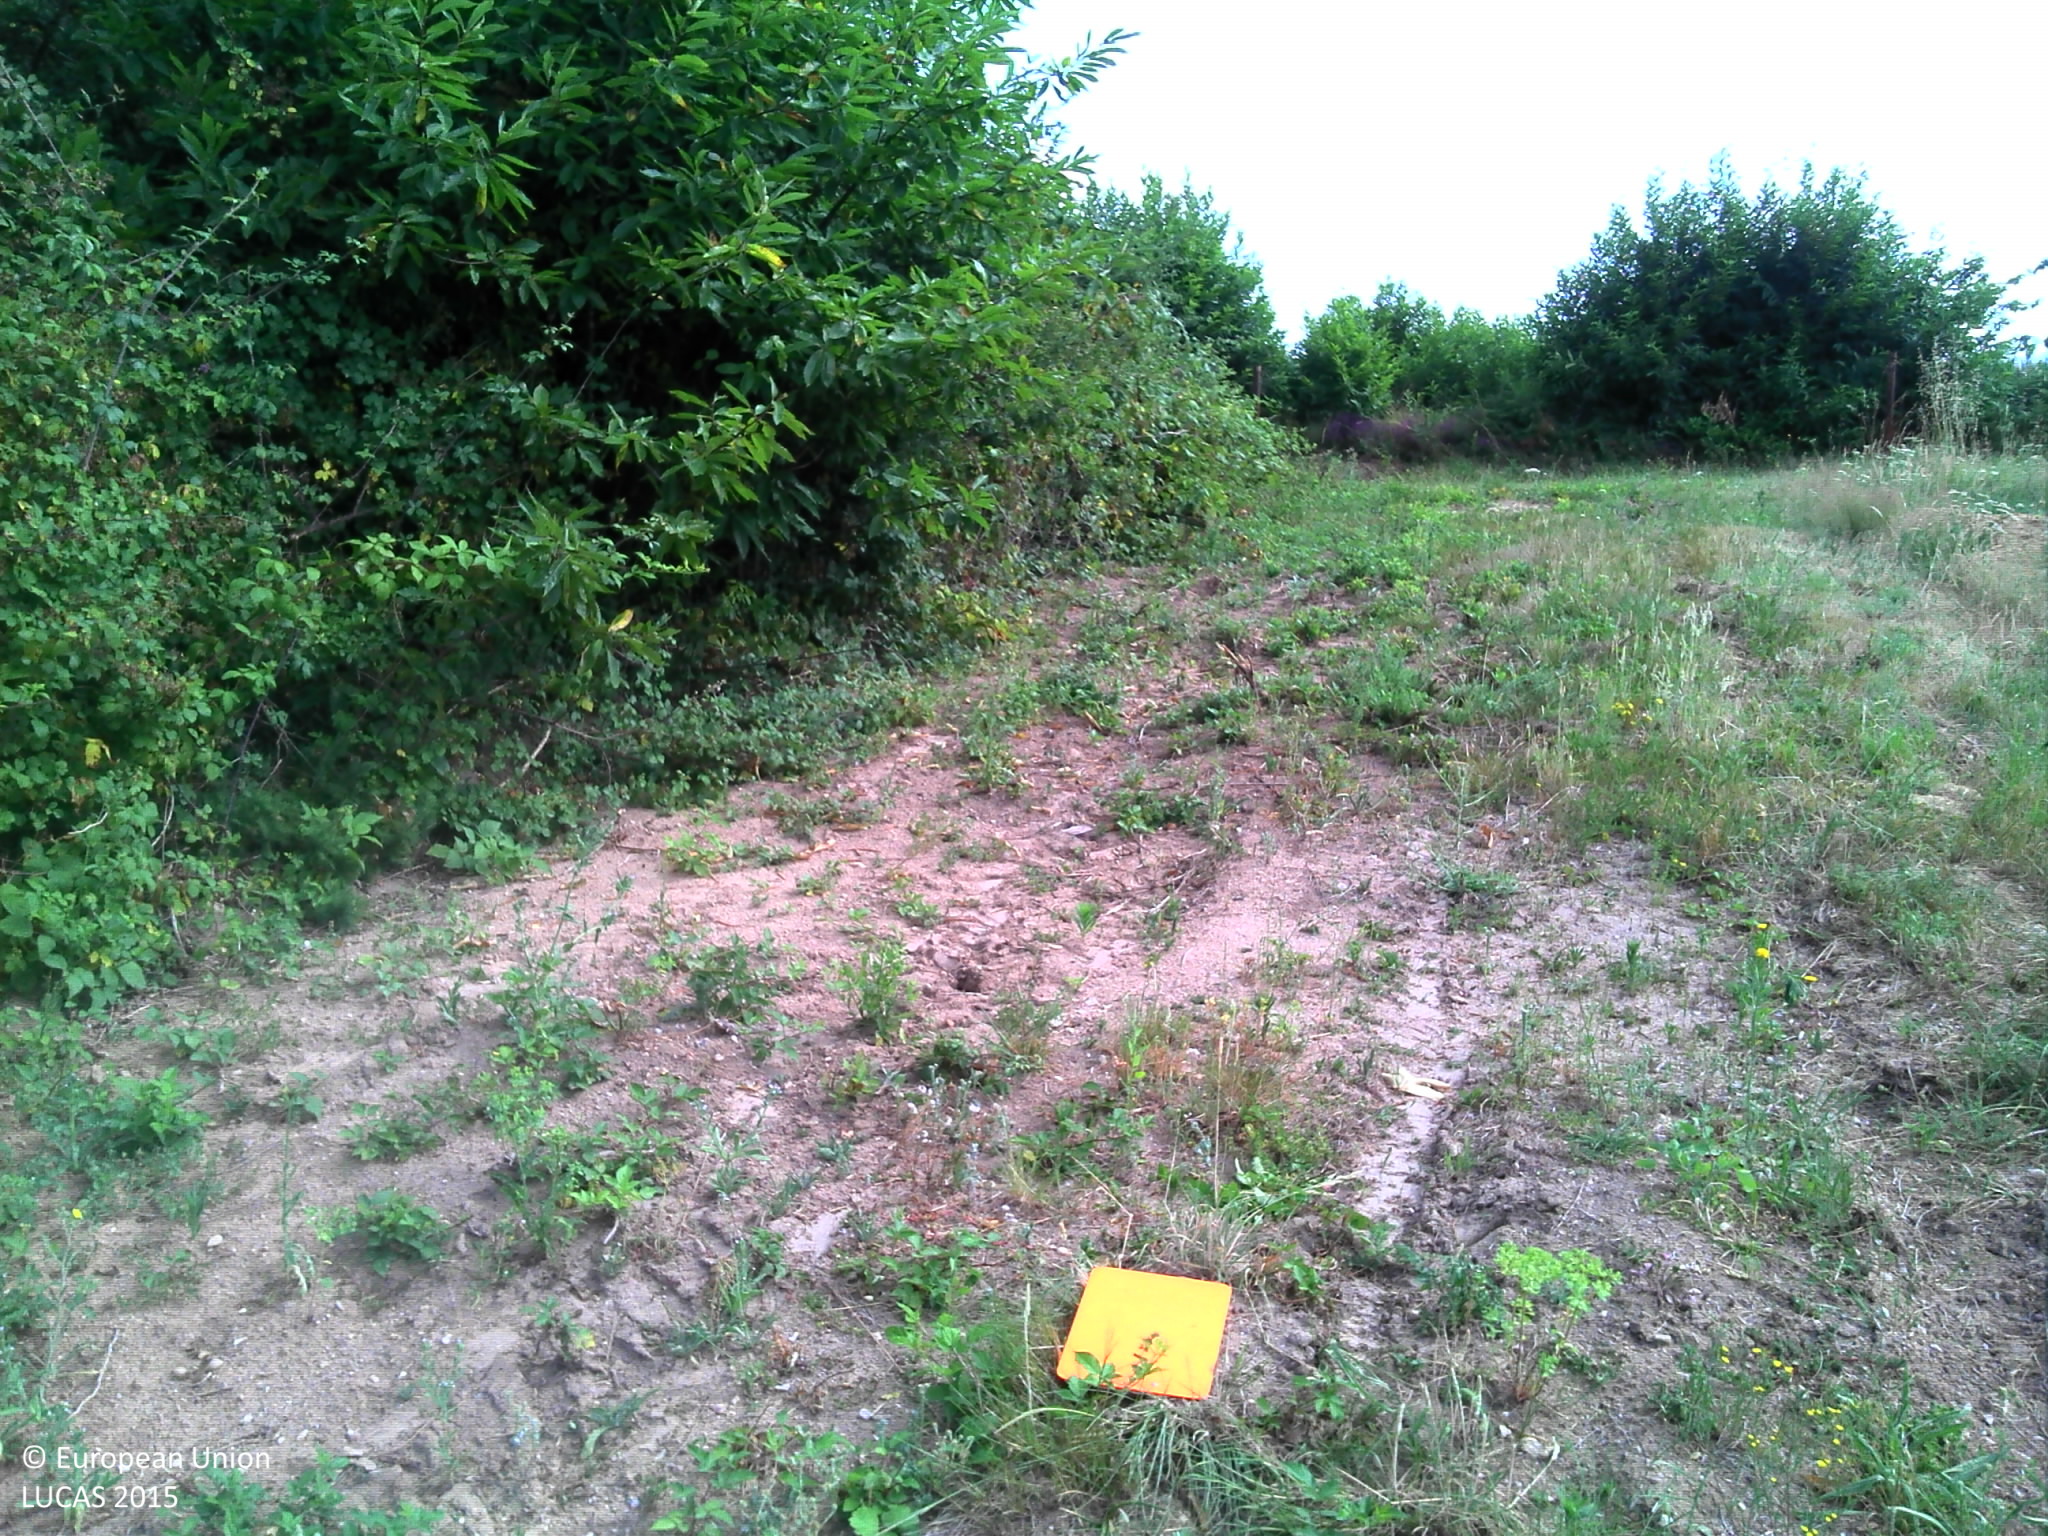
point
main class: Grassland
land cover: Spontaneously vegetated surfaces
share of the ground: > 75 %
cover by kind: herbaceous plants 95 %, shrubs 5 %
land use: Semi-natural and natural areas not in use
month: July
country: FR
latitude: 45.3352
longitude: -0.5743
